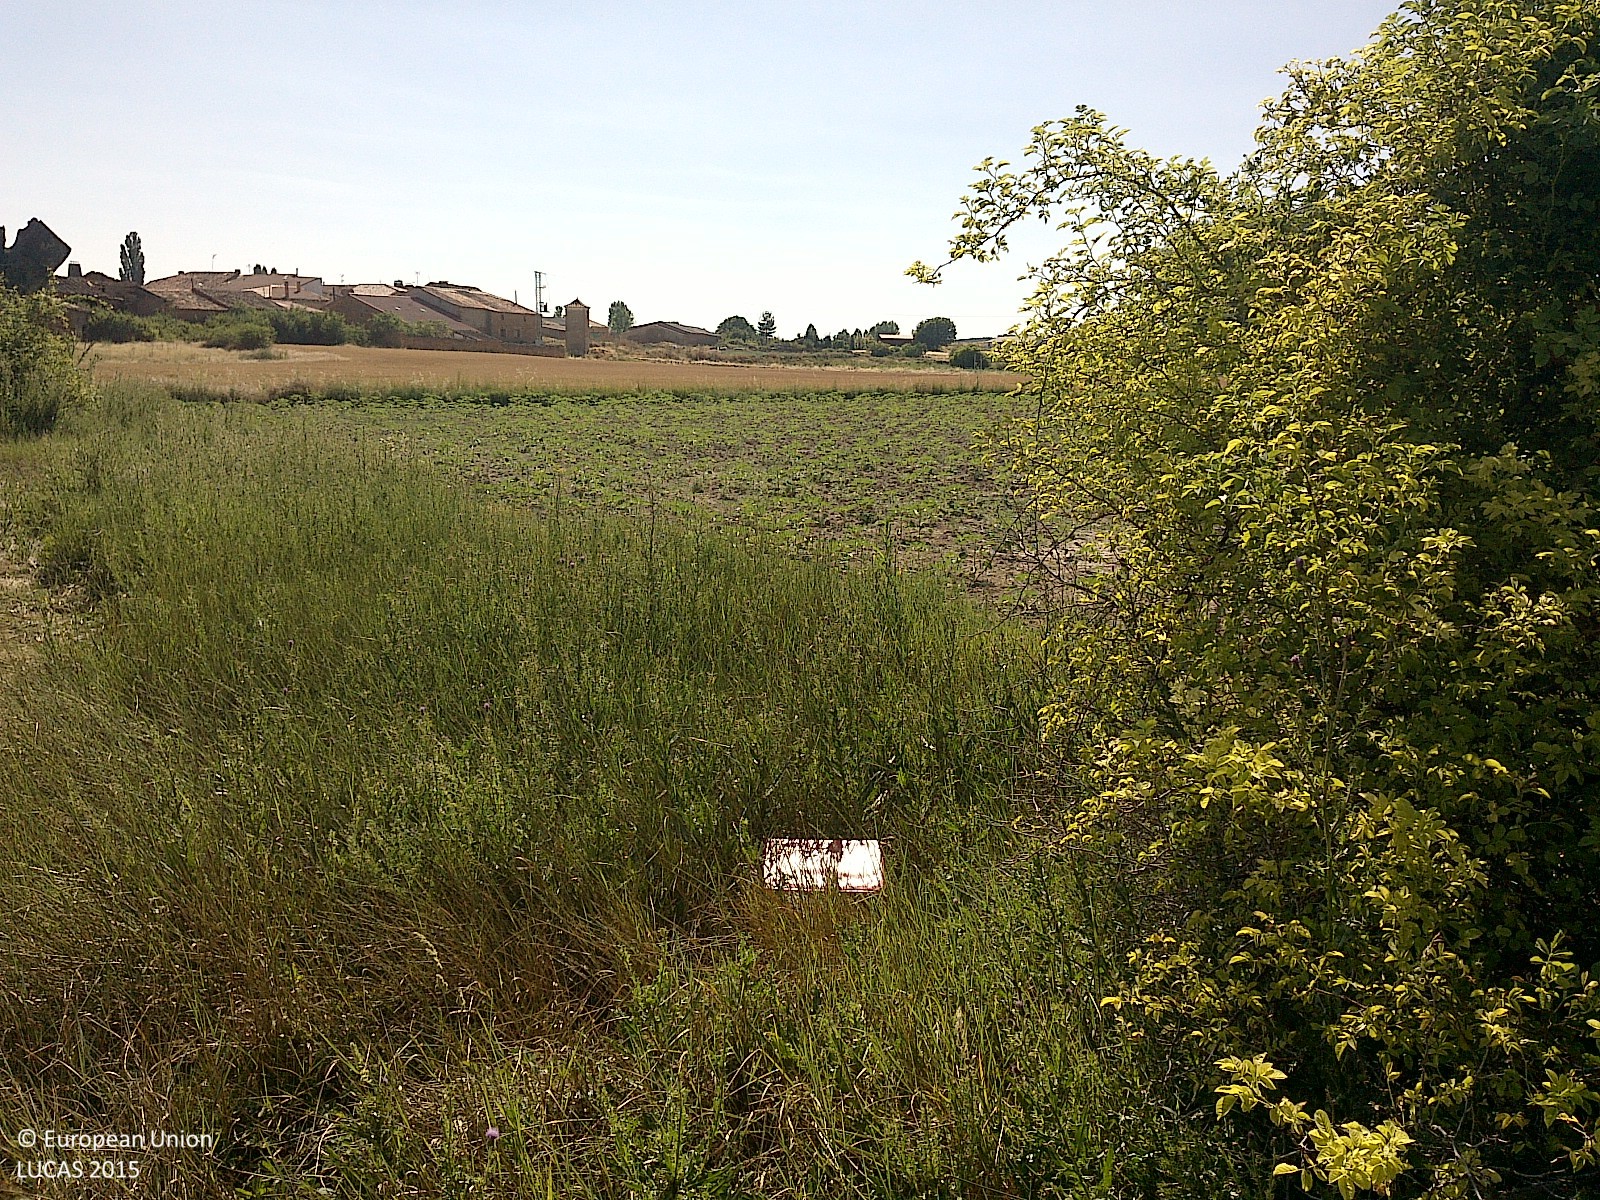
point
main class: Grassland
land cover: Spontaneously vegetated surfaces
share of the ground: > 75 %
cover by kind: herbaceous plants 95 %, shrubs 5 %
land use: Semi-natural and natural areas not in use
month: July
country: ES
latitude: 41.6046
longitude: -2.7705
